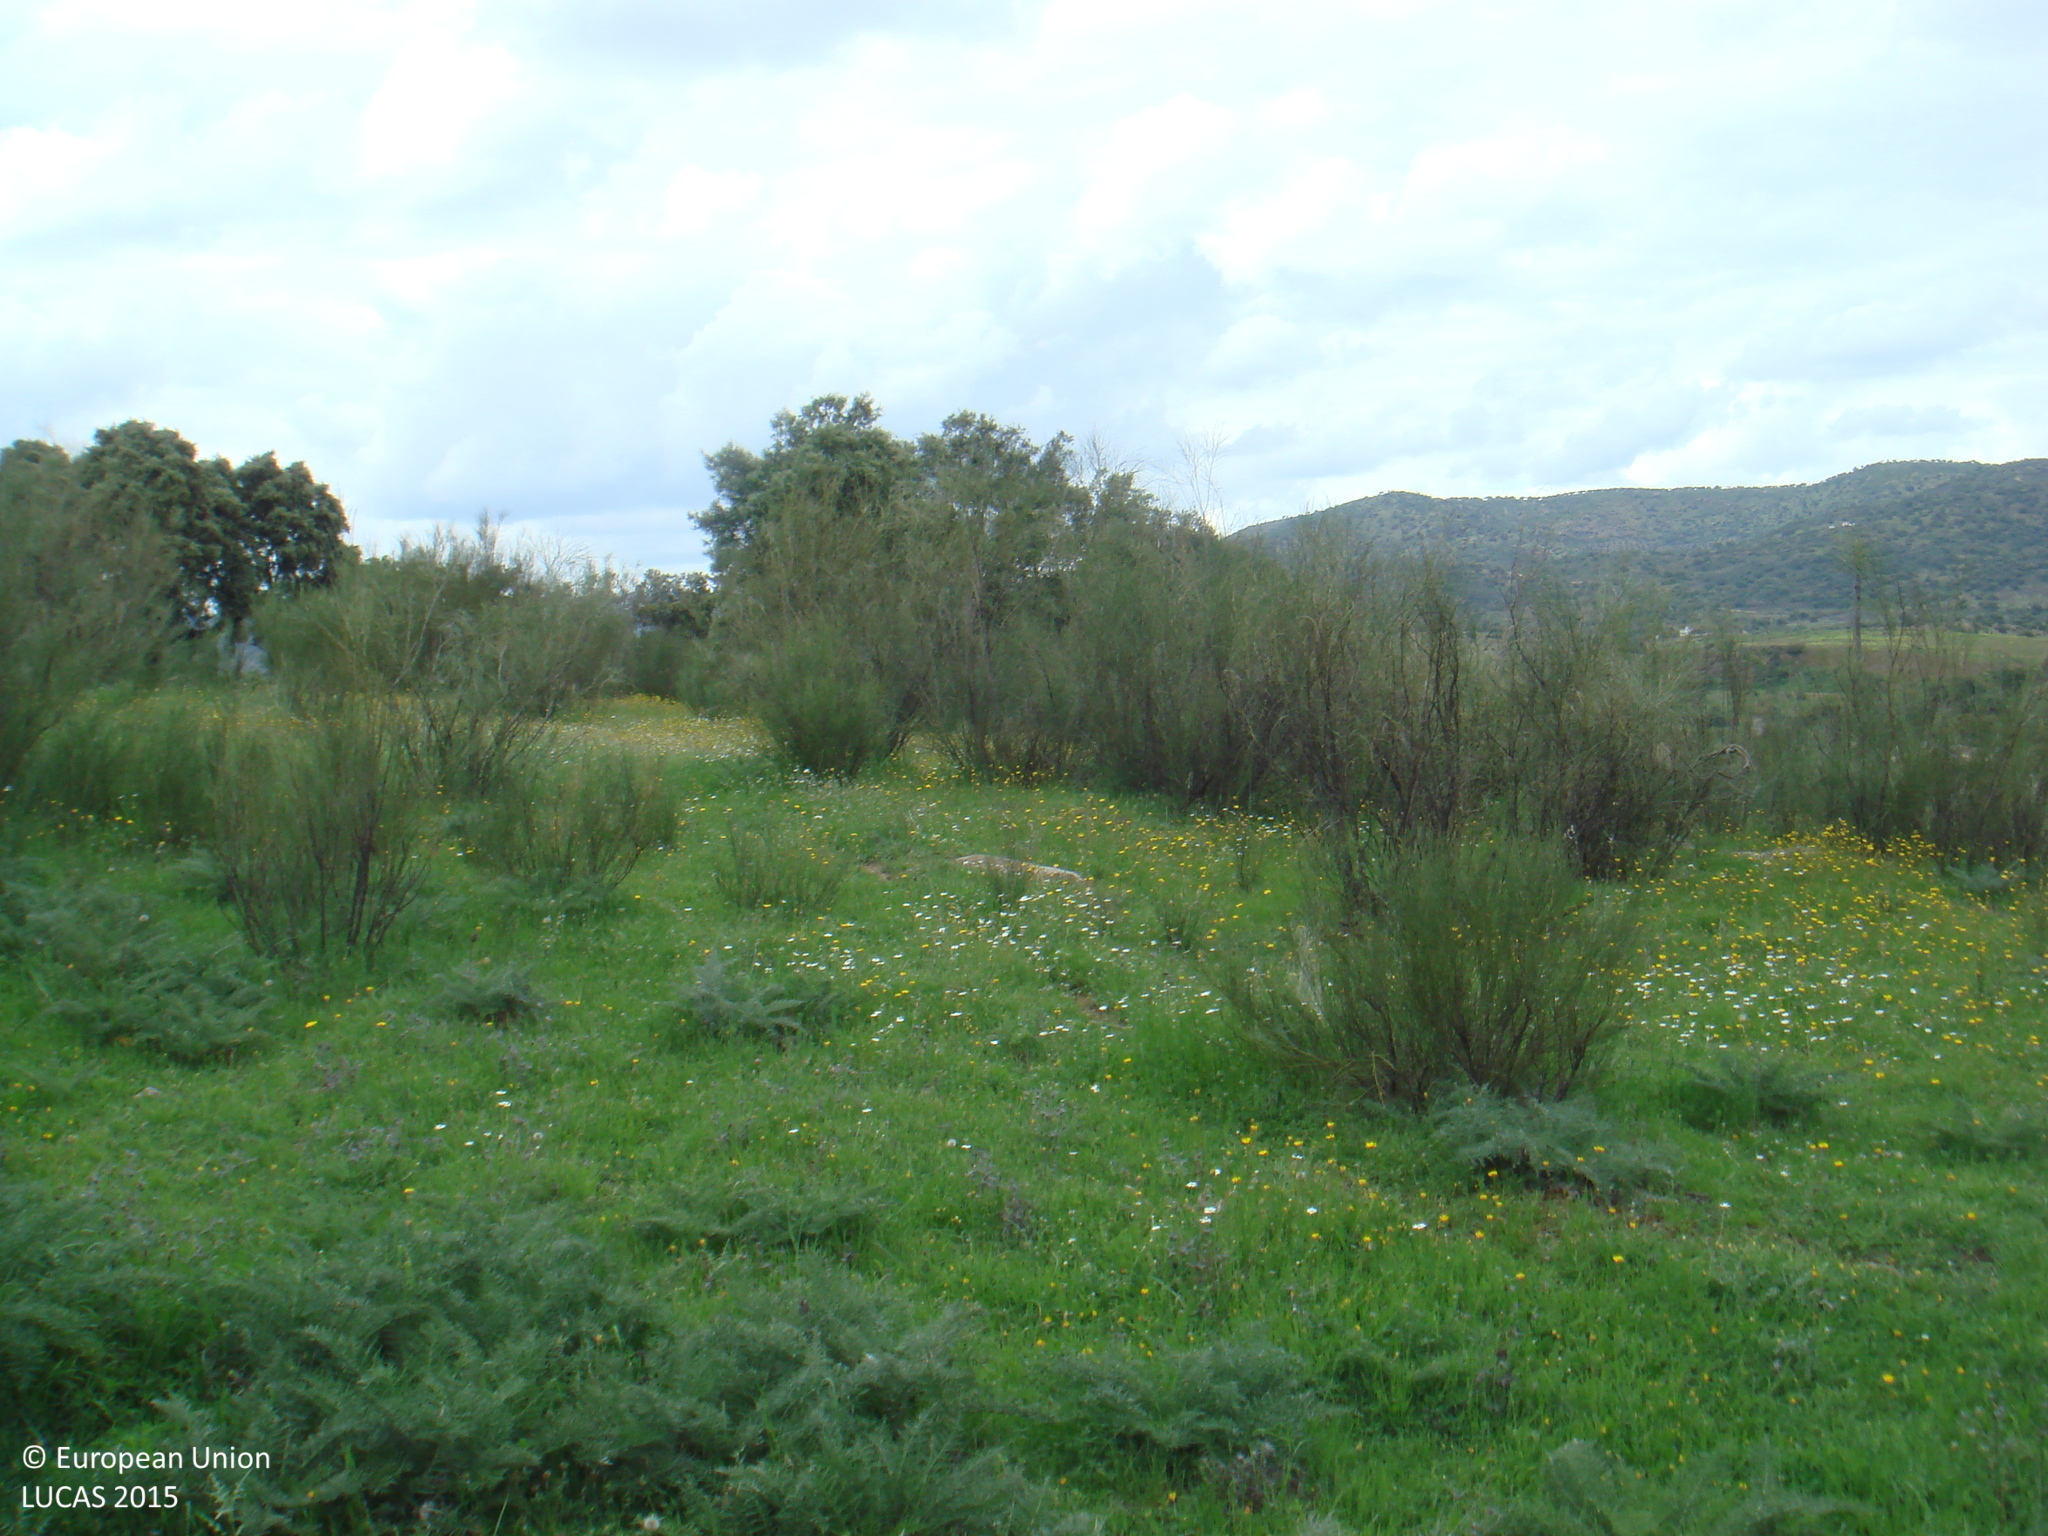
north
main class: Shrubland
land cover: Shrubland with sparse tree cover
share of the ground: > 75 %
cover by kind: shrubs 70 %, herbaceous plants 25 %, broadleaved forest trees 5 %
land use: Forestry
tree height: > 5 m
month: April
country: ES
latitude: 38.1823
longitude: -5.0354
